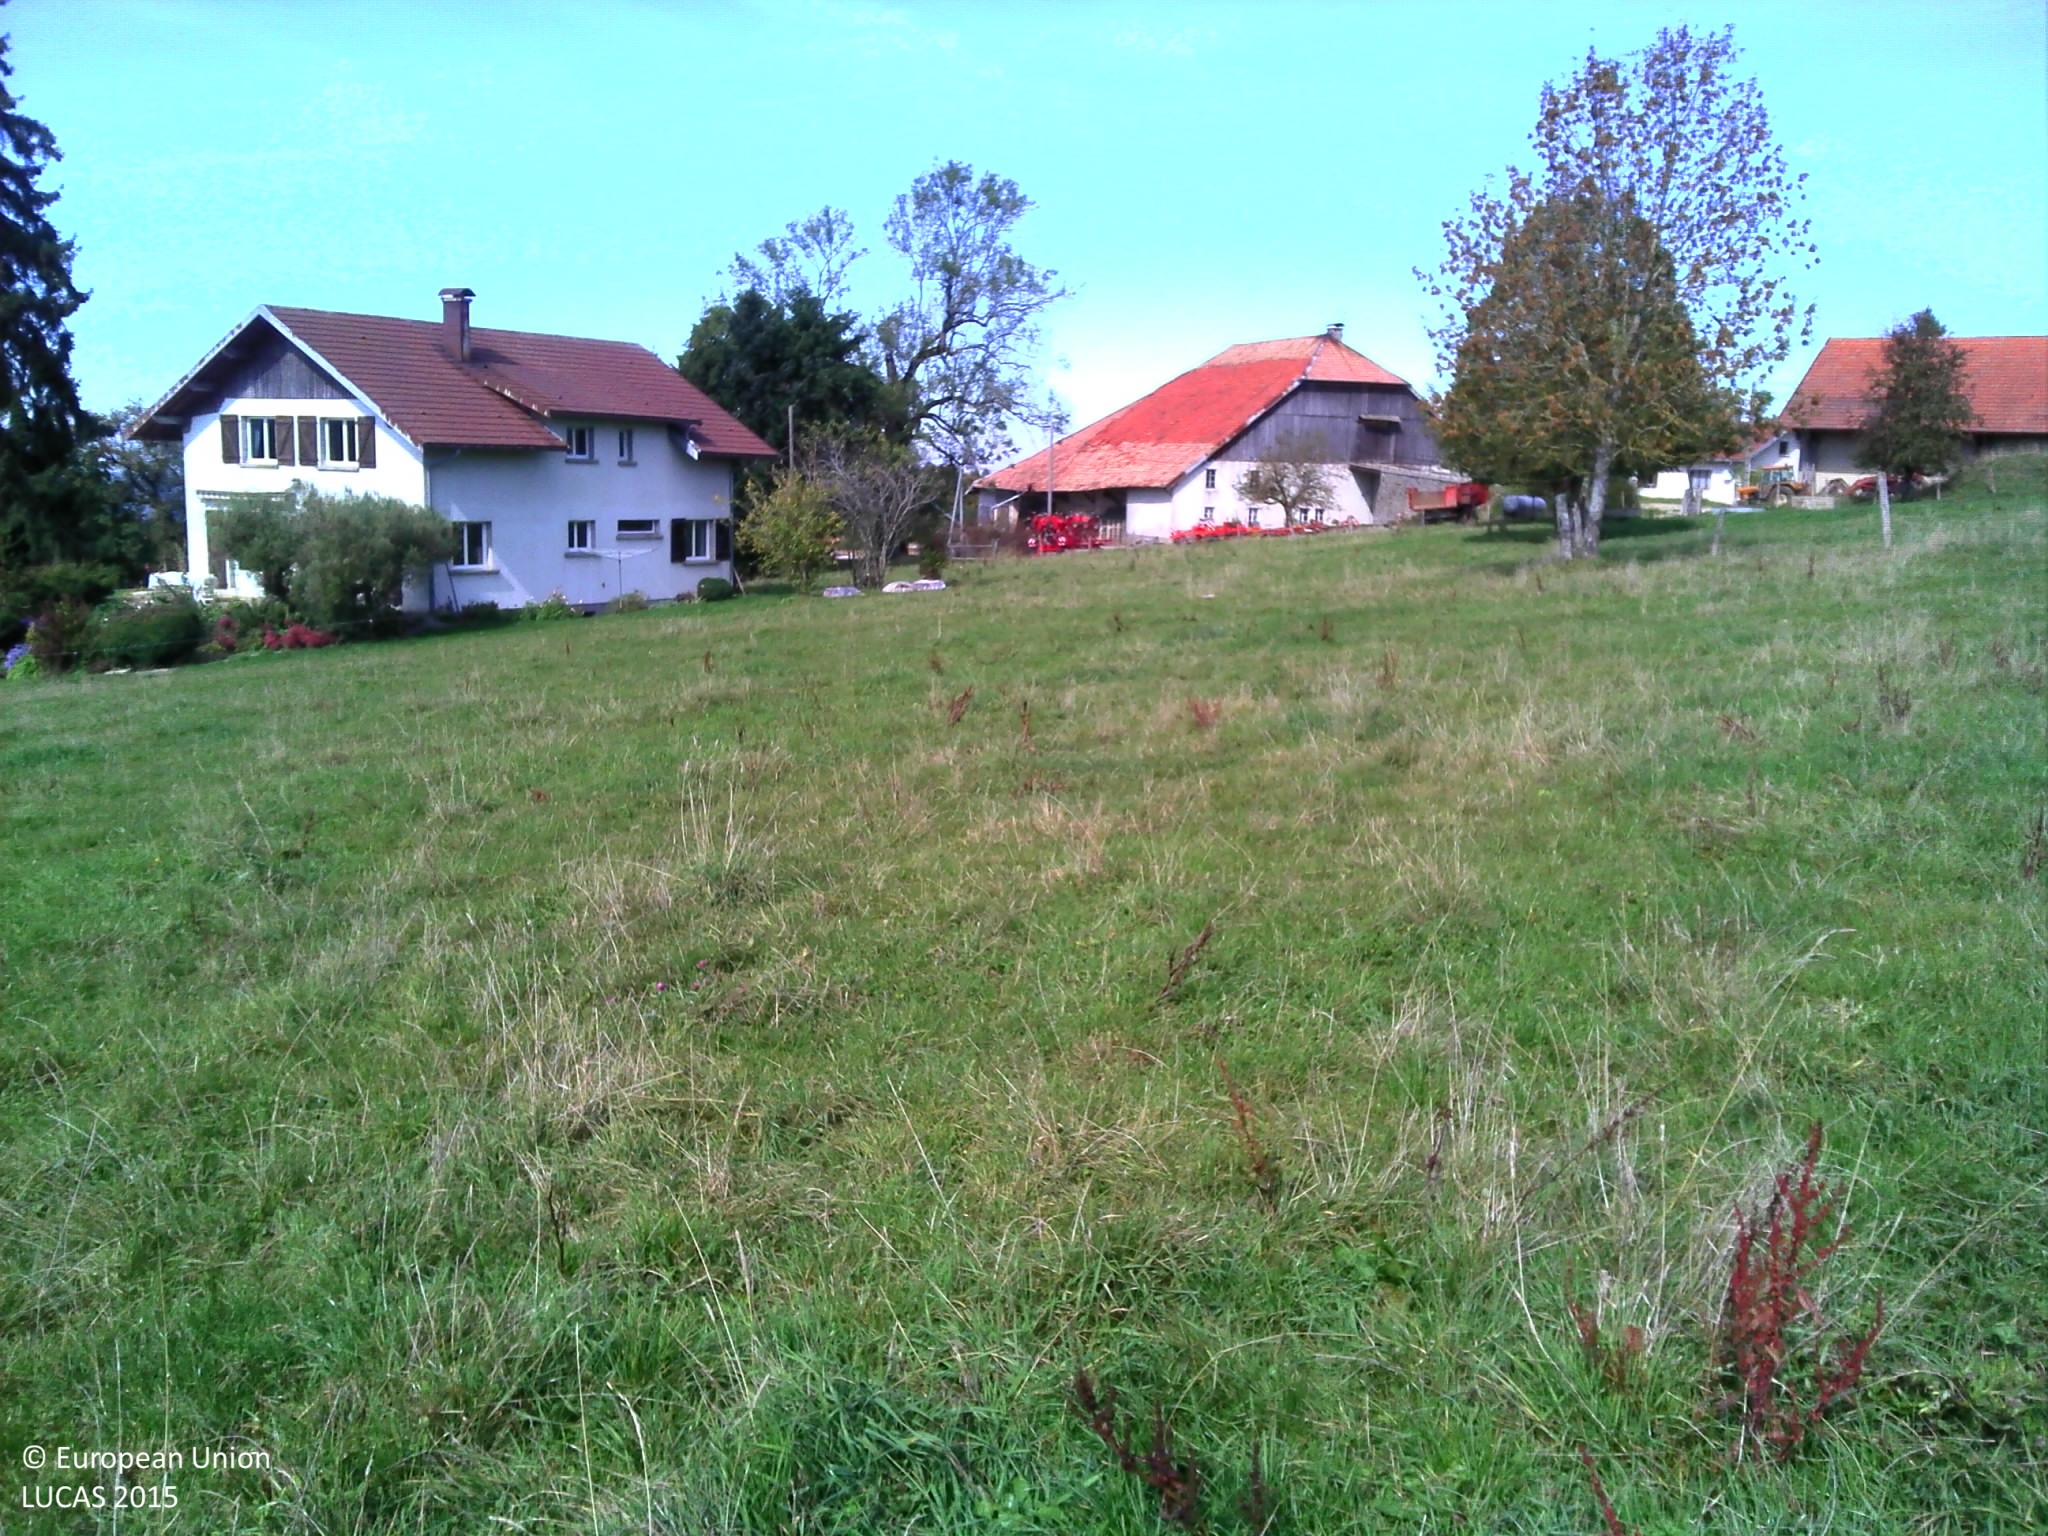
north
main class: Grassland
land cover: Grassland without tree/shrub cover
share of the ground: > 75 %
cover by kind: herbaceous plants 100 %
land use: Agriculture (excluding fallow land and kitchen gardens)
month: October
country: FR
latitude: 46.9914
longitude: 6.3337
